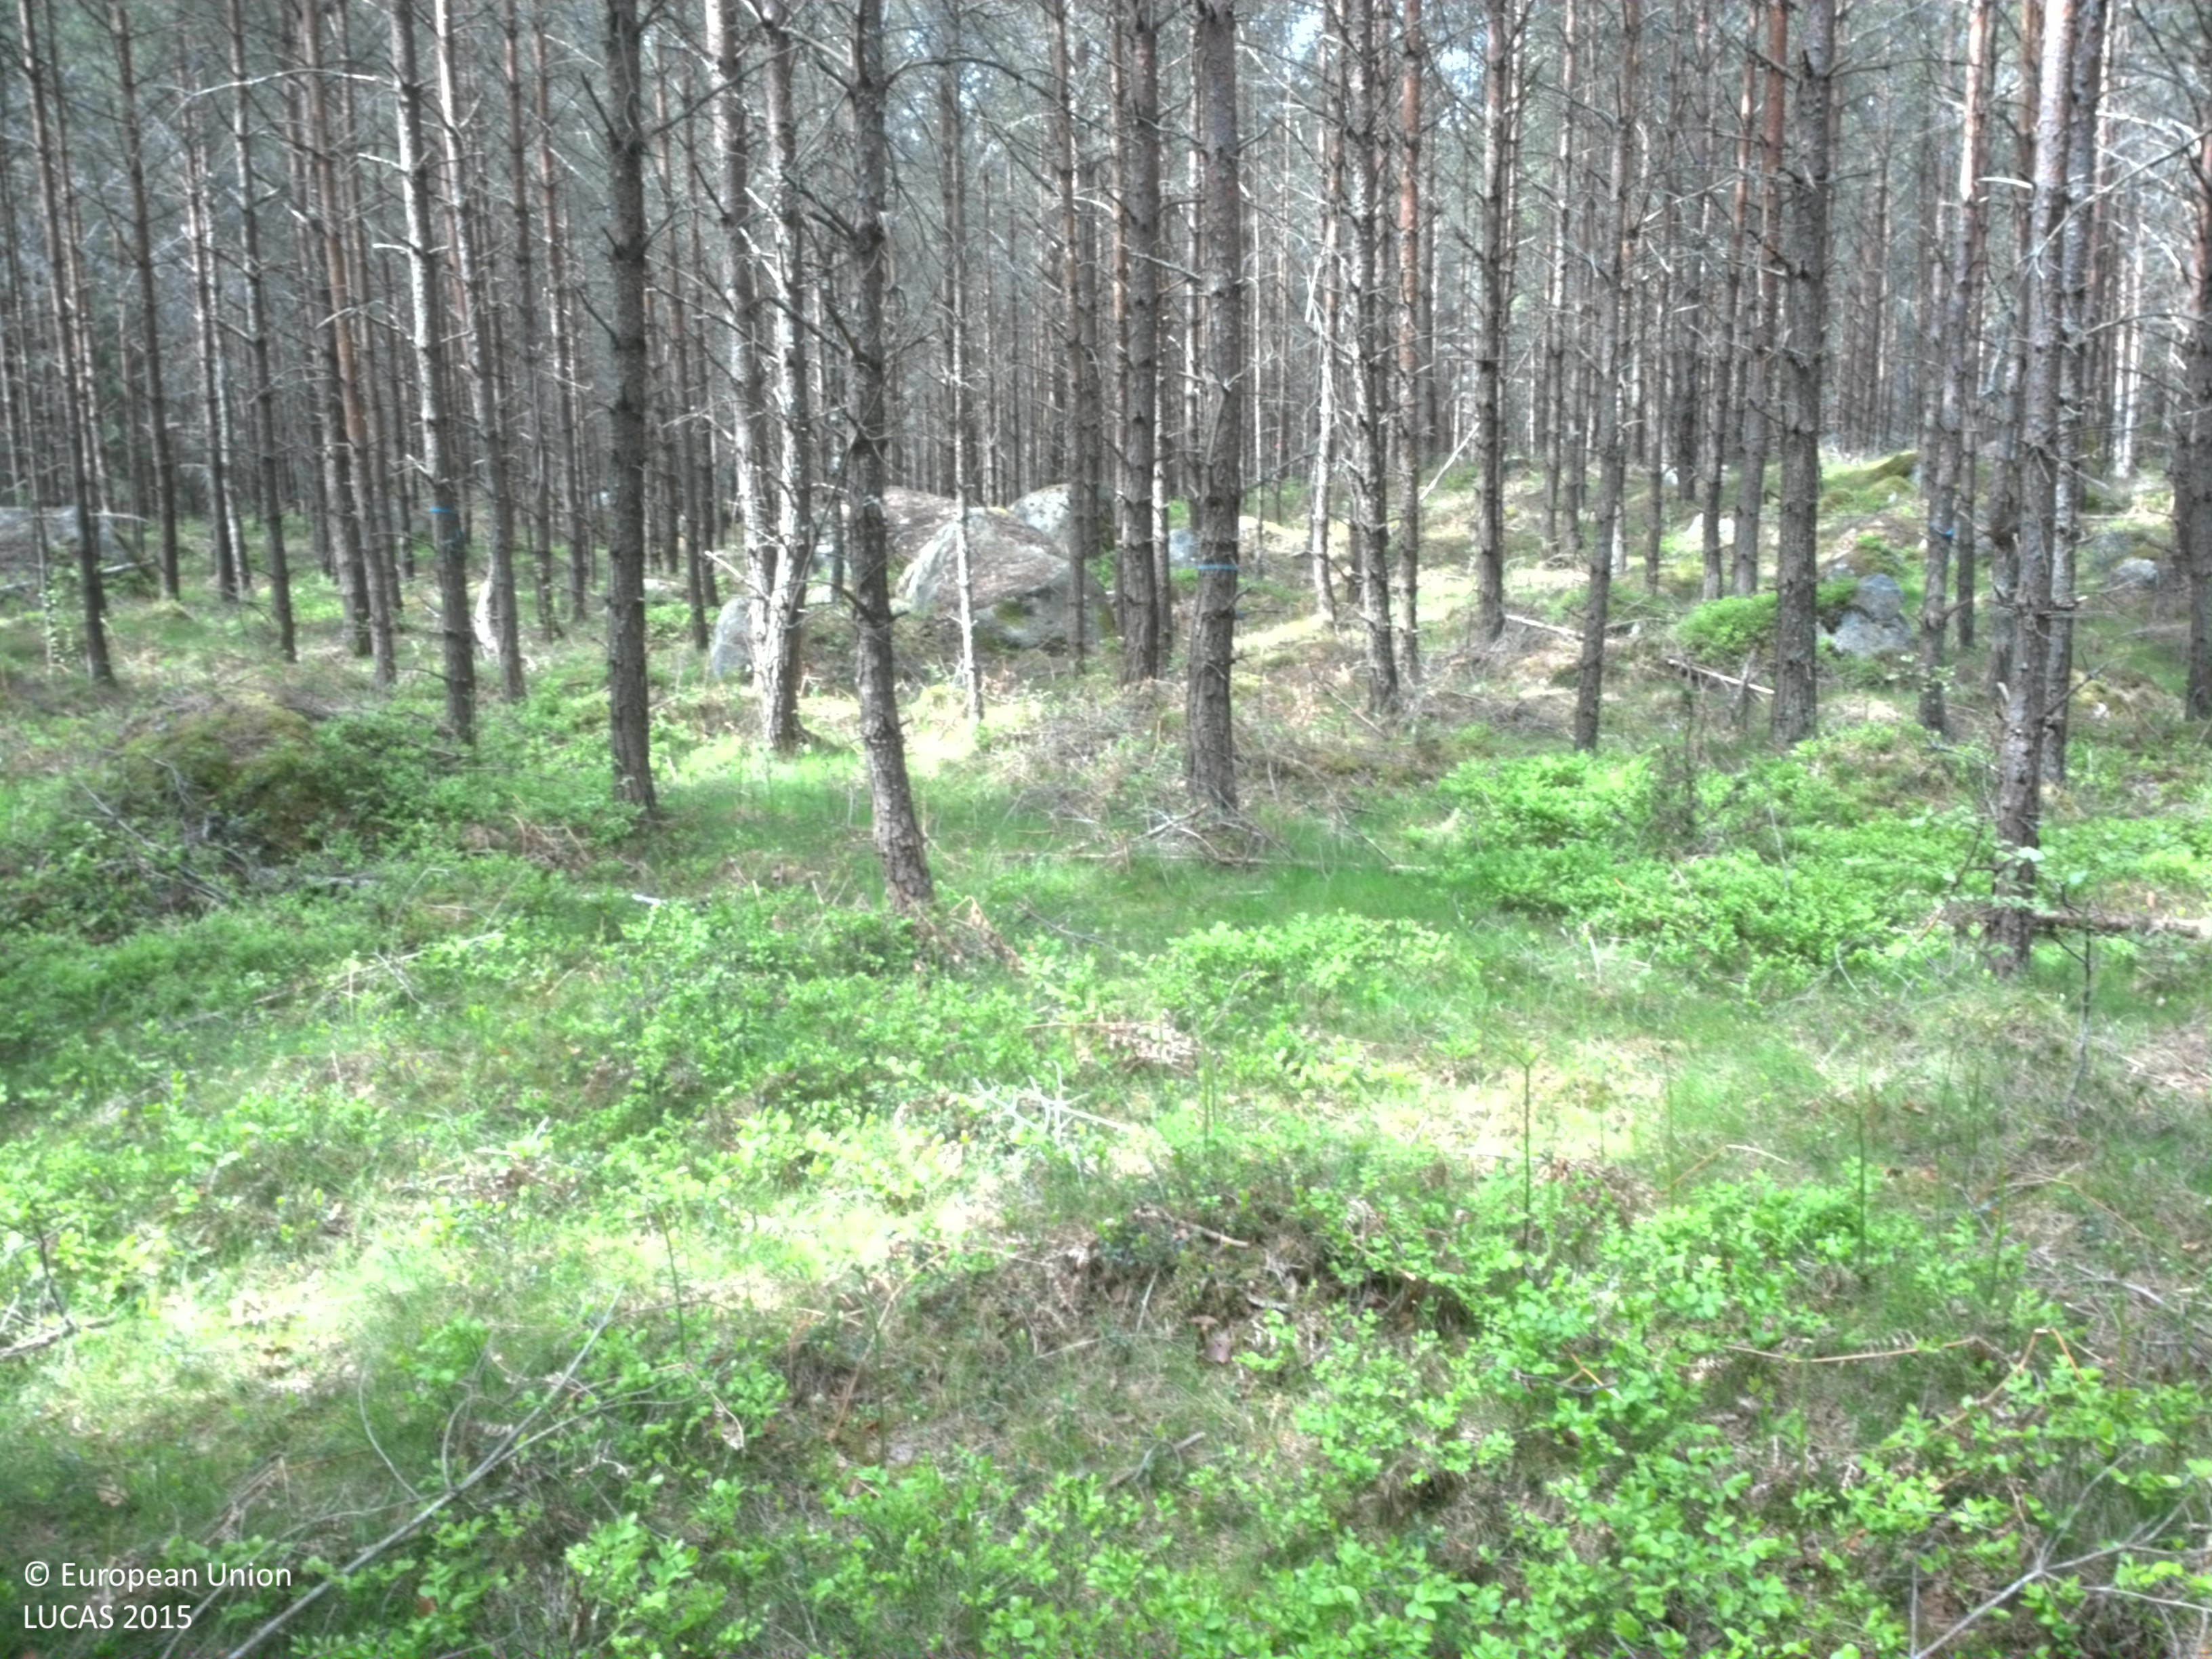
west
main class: Woodland
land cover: Pine dominated coniferous woodland
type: boreal forest
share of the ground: > 75 %
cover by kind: coniferous forest trees 85 %, shrubs 15 %
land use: Forestry
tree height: > 5 m
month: May
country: SE
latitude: 56.5514
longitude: 15.1876
